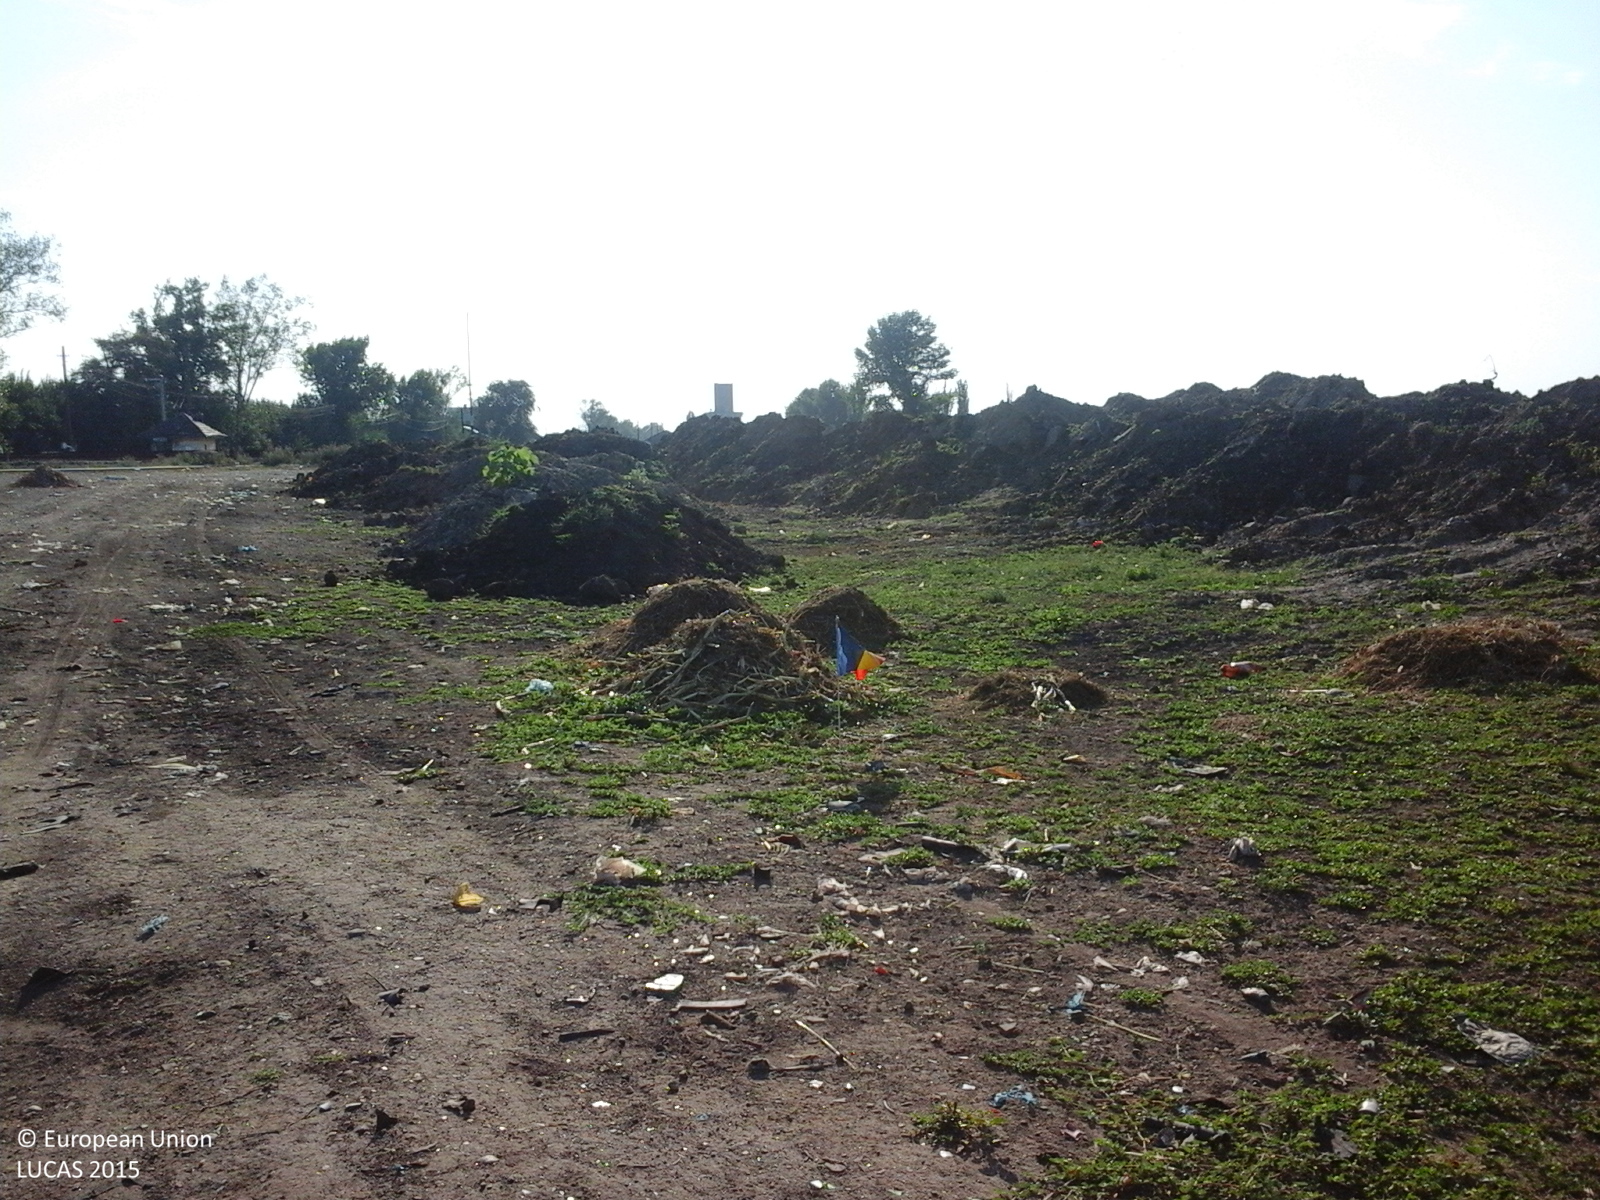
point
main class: Grassland
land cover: Spontaneously vegetated surfaces
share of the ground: 50 - 75 %
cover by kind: herbaceous plants 100 %
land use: Abandoned areas
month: August
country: RO
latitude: 44.0346
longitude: 23.1839
